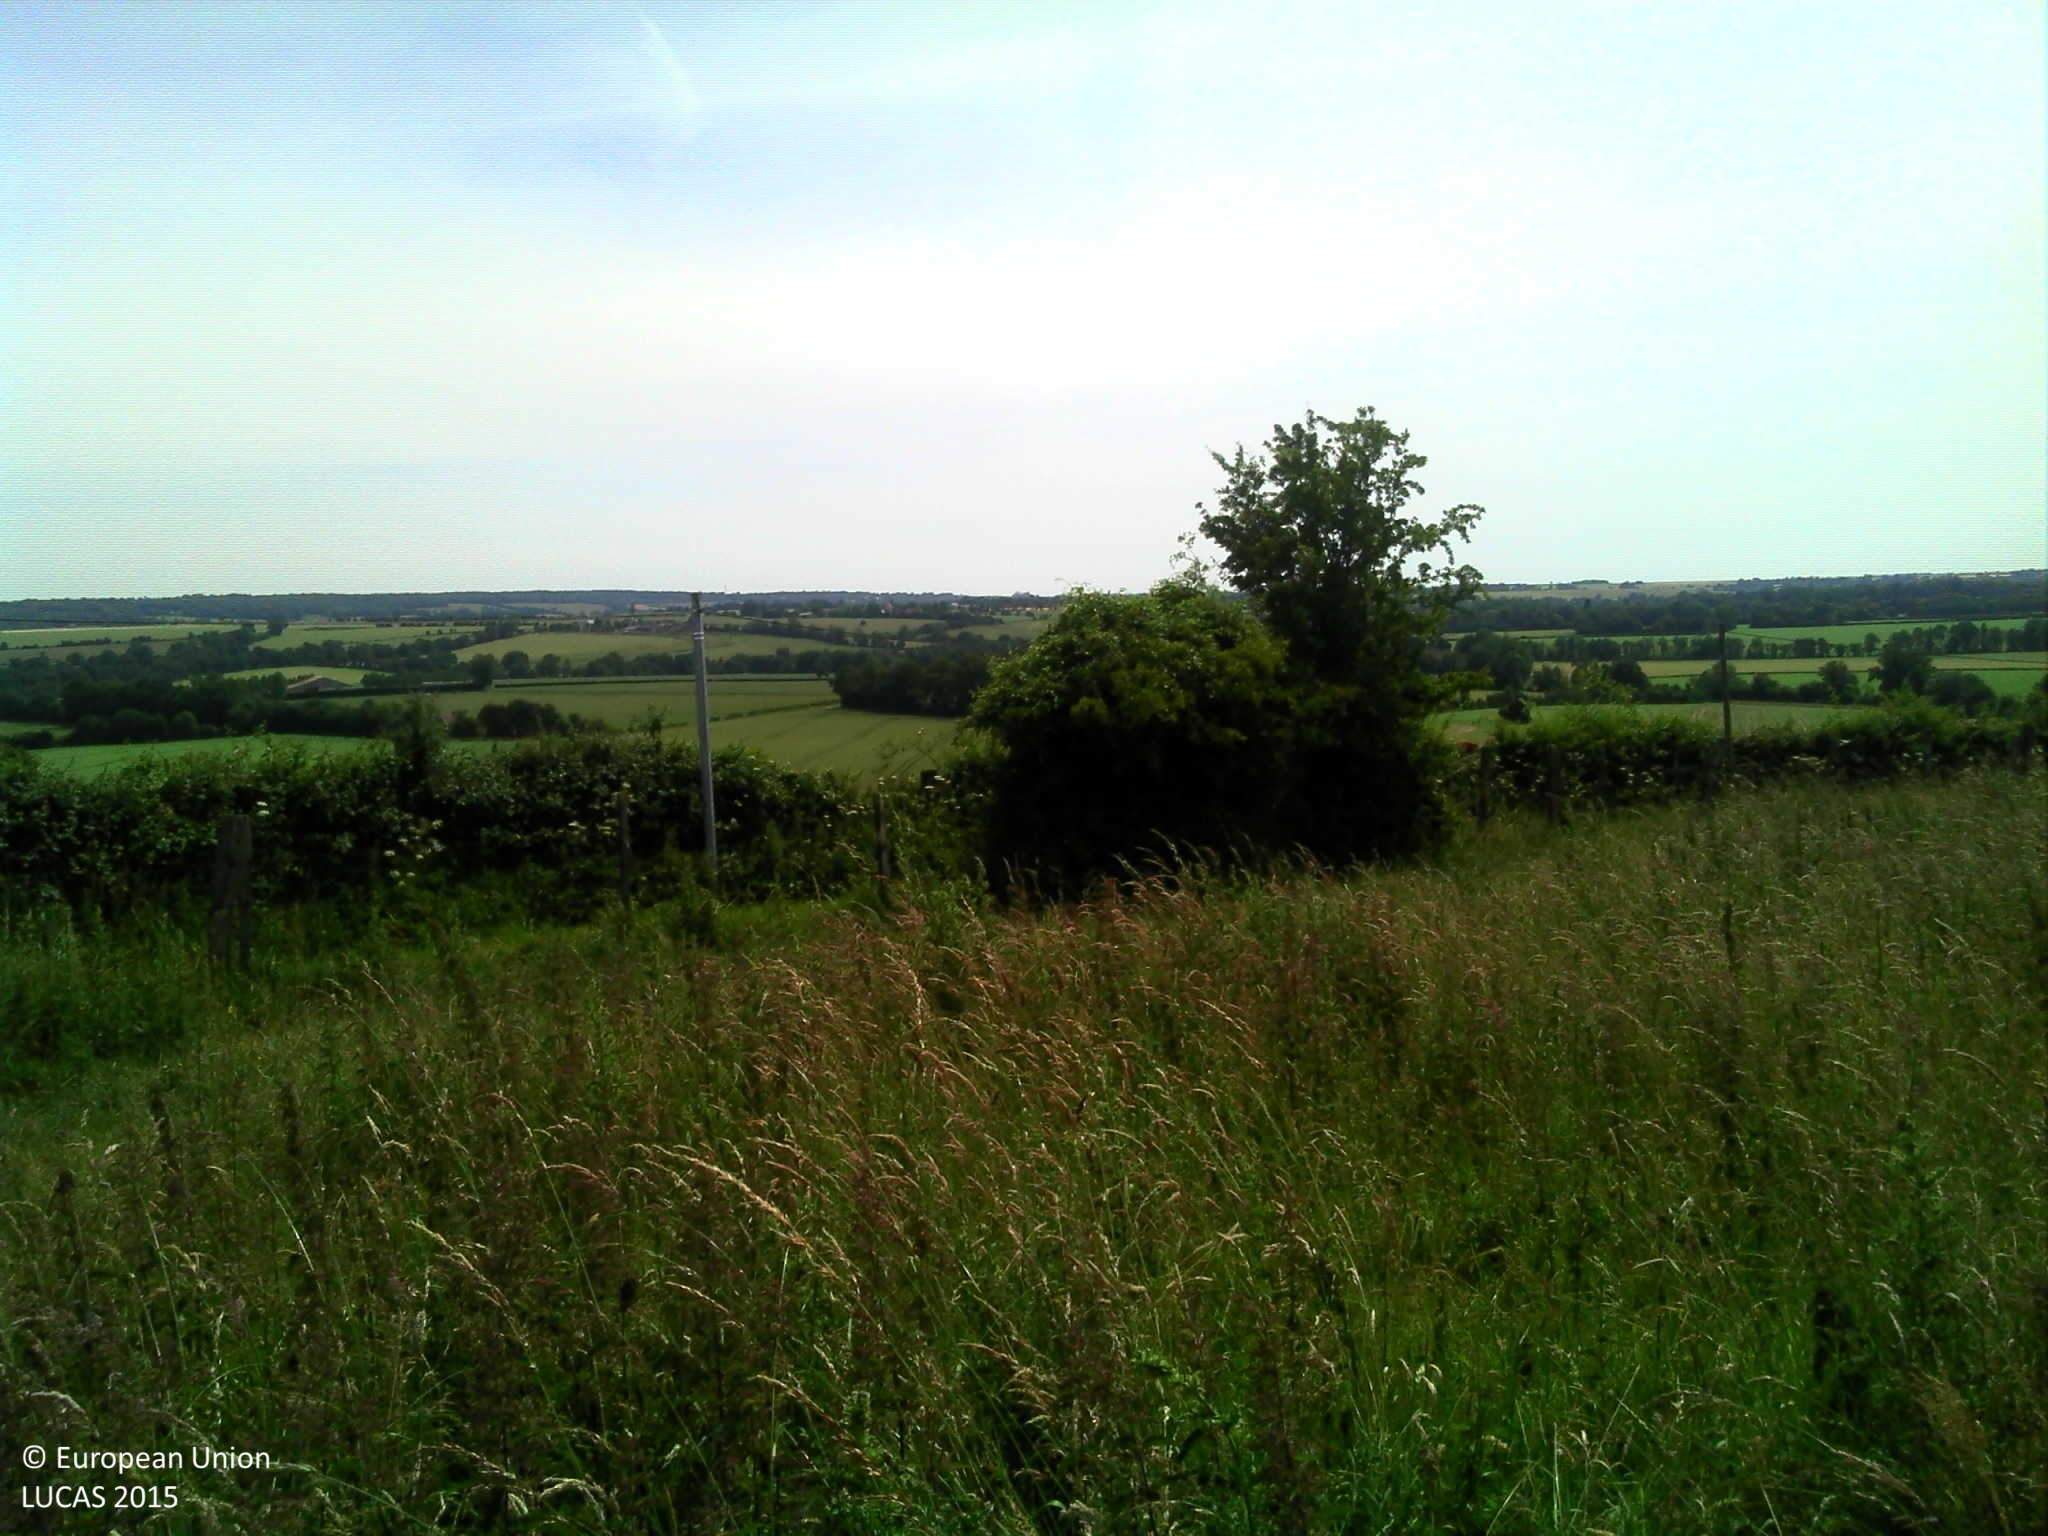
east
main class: Grassland
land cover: Grassland without tree/shrub cover
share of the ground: > 75 %
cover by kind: herbaceous plants 100 %
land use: Agriculture (excluding fallow land and kitchen gardens)
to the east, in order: Grassland without tree/shrub cover; Fences; Grass margins; Paved roads, cycling and walking lanes; Grass margins; Electric lines; Fences; Managed hedges; Grassland without tree/shrub cover; Managed hedges; Electric lines; Grass margins; Paved roads, cycling and walking lanes; Grass margins; Maize
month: June
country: FR
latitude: 48.8161
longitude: -0.2331
